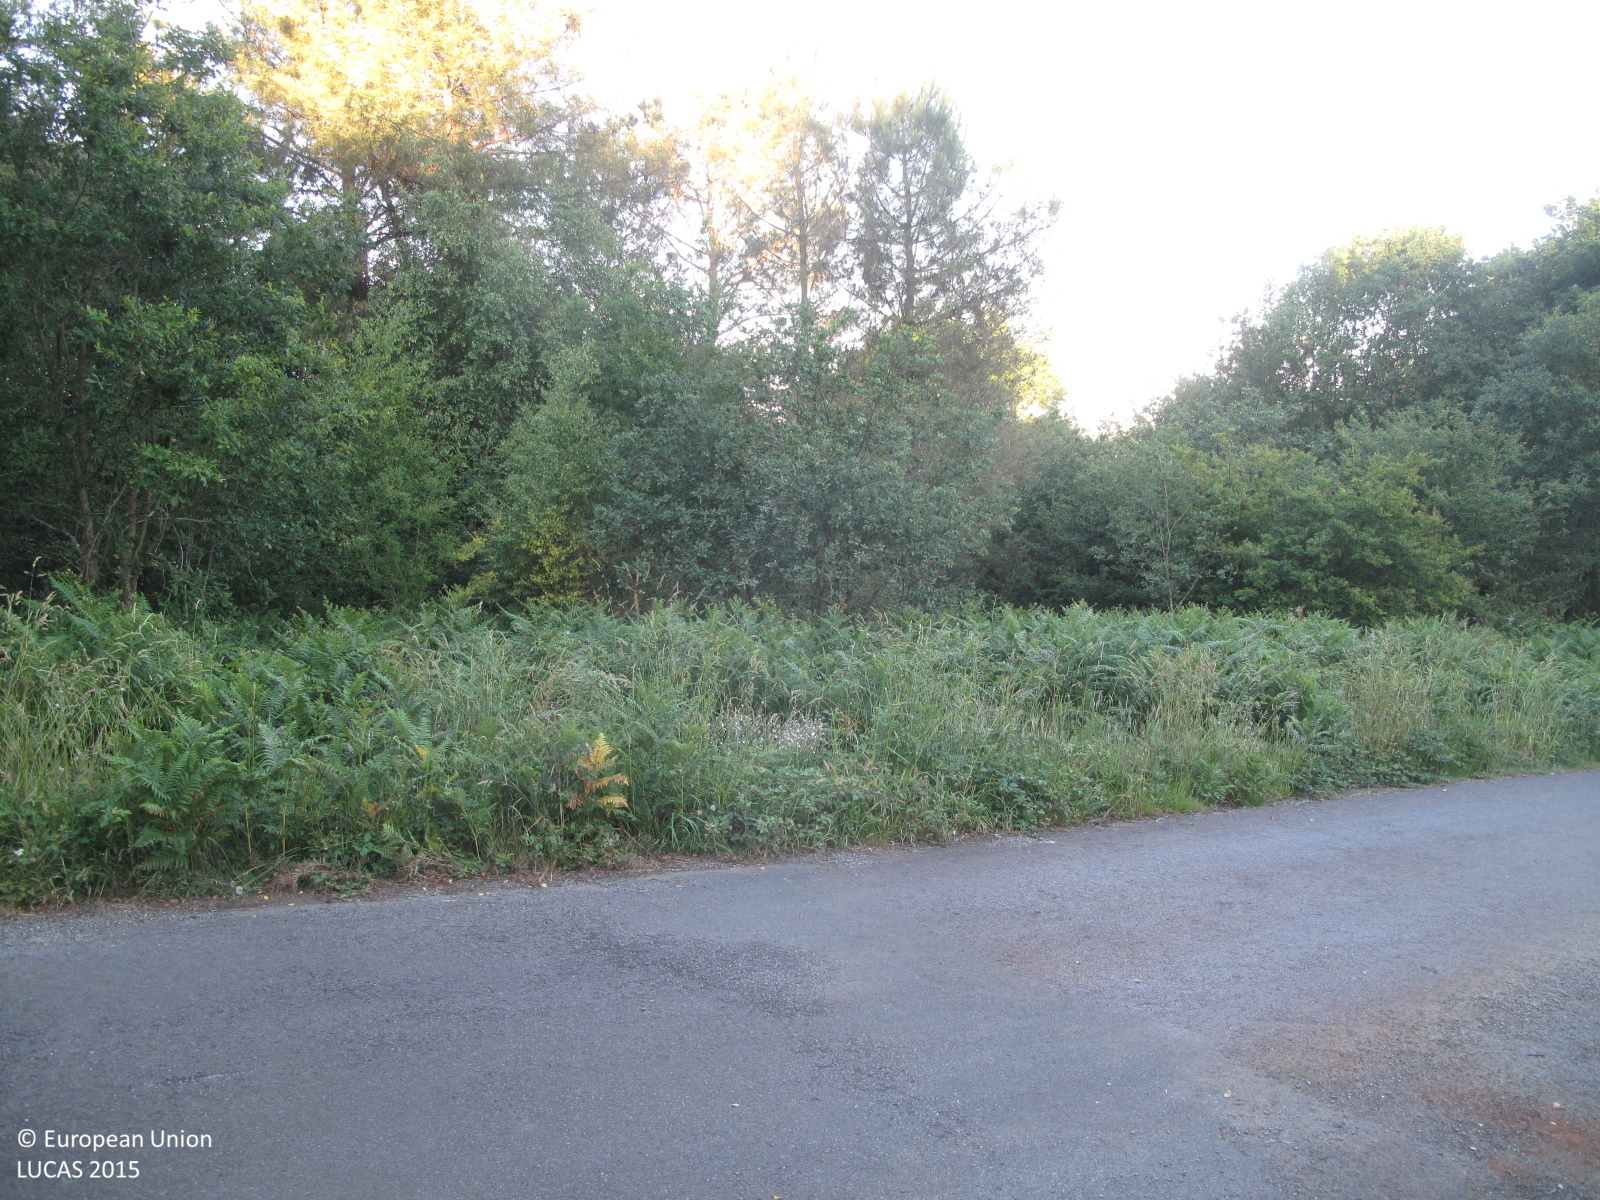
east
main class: Woodland
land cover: Broadleaved woodland
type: thermophilous deciduous forest
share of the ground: 10 - 25 %
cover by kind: herbaceous plants 70 %, broadleaved forest trees 20 %, shrubs 10 %
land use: Forestry
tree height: > 5 m
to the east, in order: Broadleaved woodland; Fences; Grass margins; Paved roads, cycling and walking lanes; Broadleaved woodland; Tracks; Grassland with sparse tree/shrub cover; Broadleaved woodland; Paved roads, cycling and walking lanes; Shruby margins; Grassland without tree/shrub cover; Pine dominated coniferous woodland; Broadleaved woodland
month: June
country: ES
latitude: 42.9590
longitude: -8.5301
